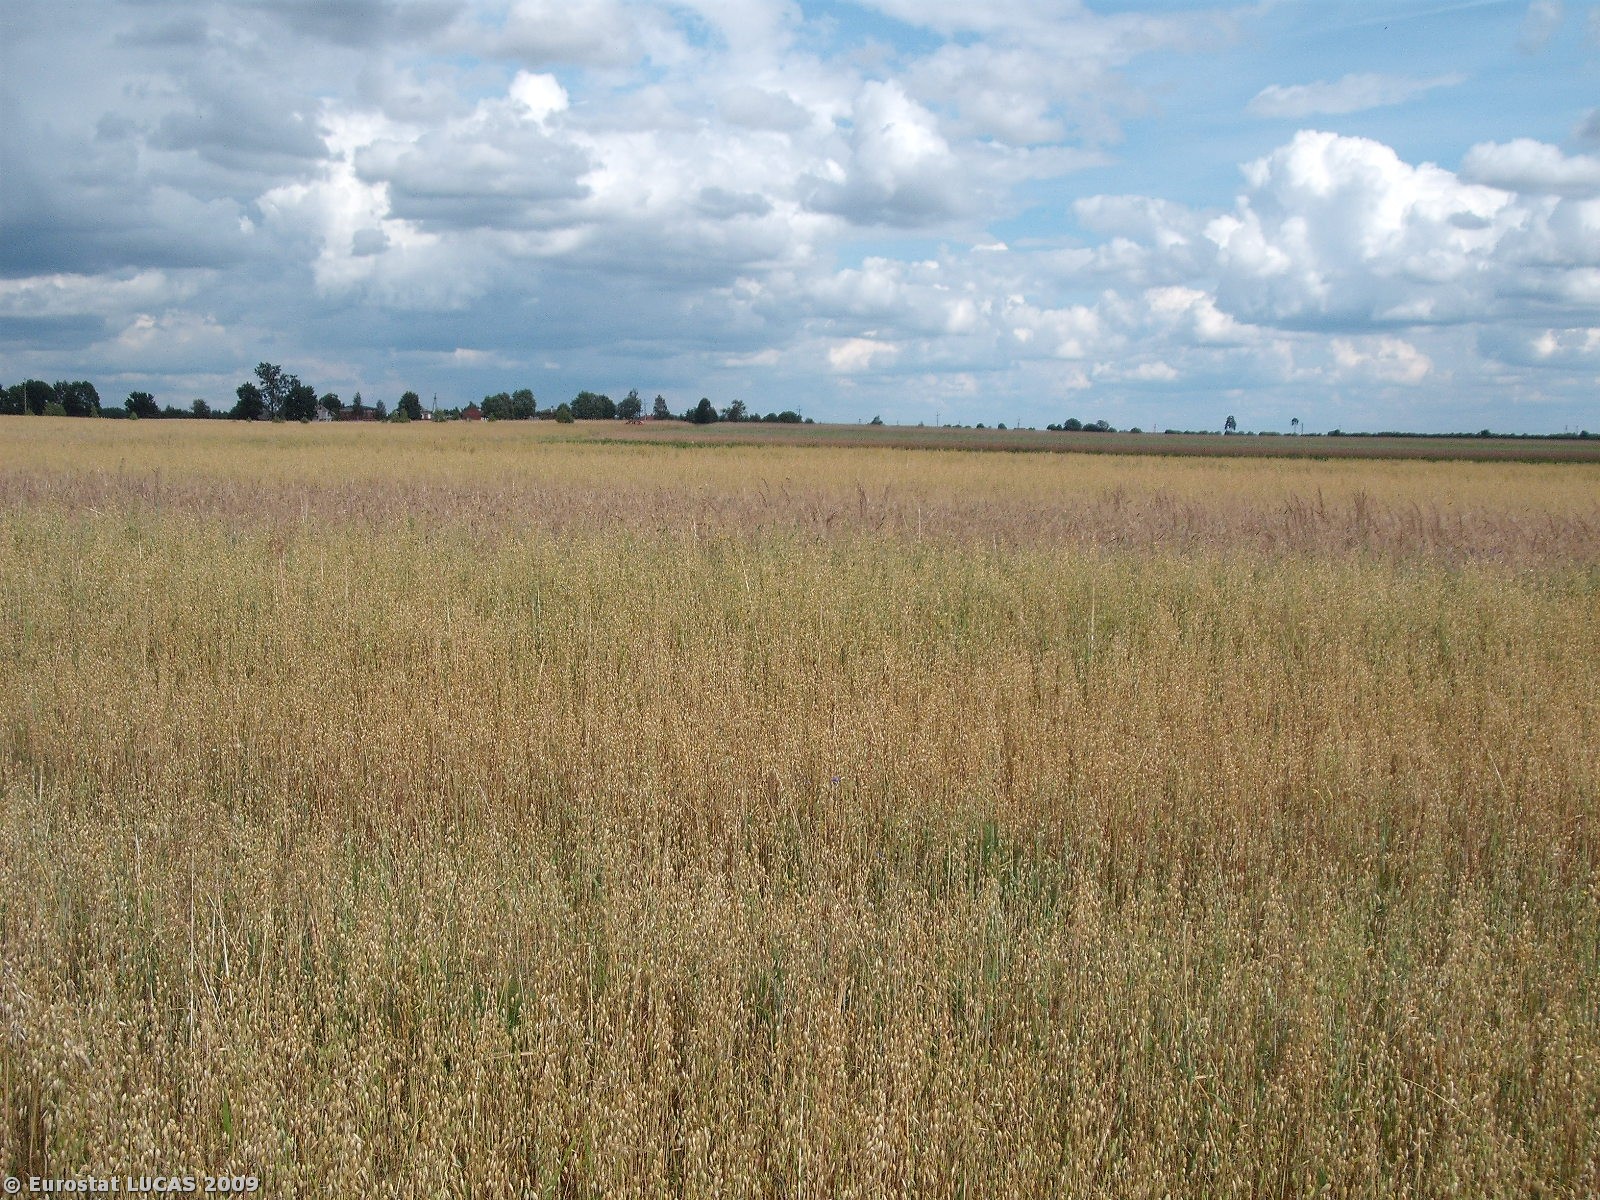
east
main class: Cropland
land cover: Oats
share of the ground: > 75 %
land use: Agriculture (excluding fallow land and kitchen gardens)
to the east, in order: Oats; Grass margins; Rye; Grass margins; Oats; Grass margins; Oats; Grass margins; Other fruit trees and berries; Grass margins; Triticale; Other cereals; Grass margins; Rye; Grass margins; Oats
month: July
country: PL
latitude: 51.1050
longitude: 21.3461
